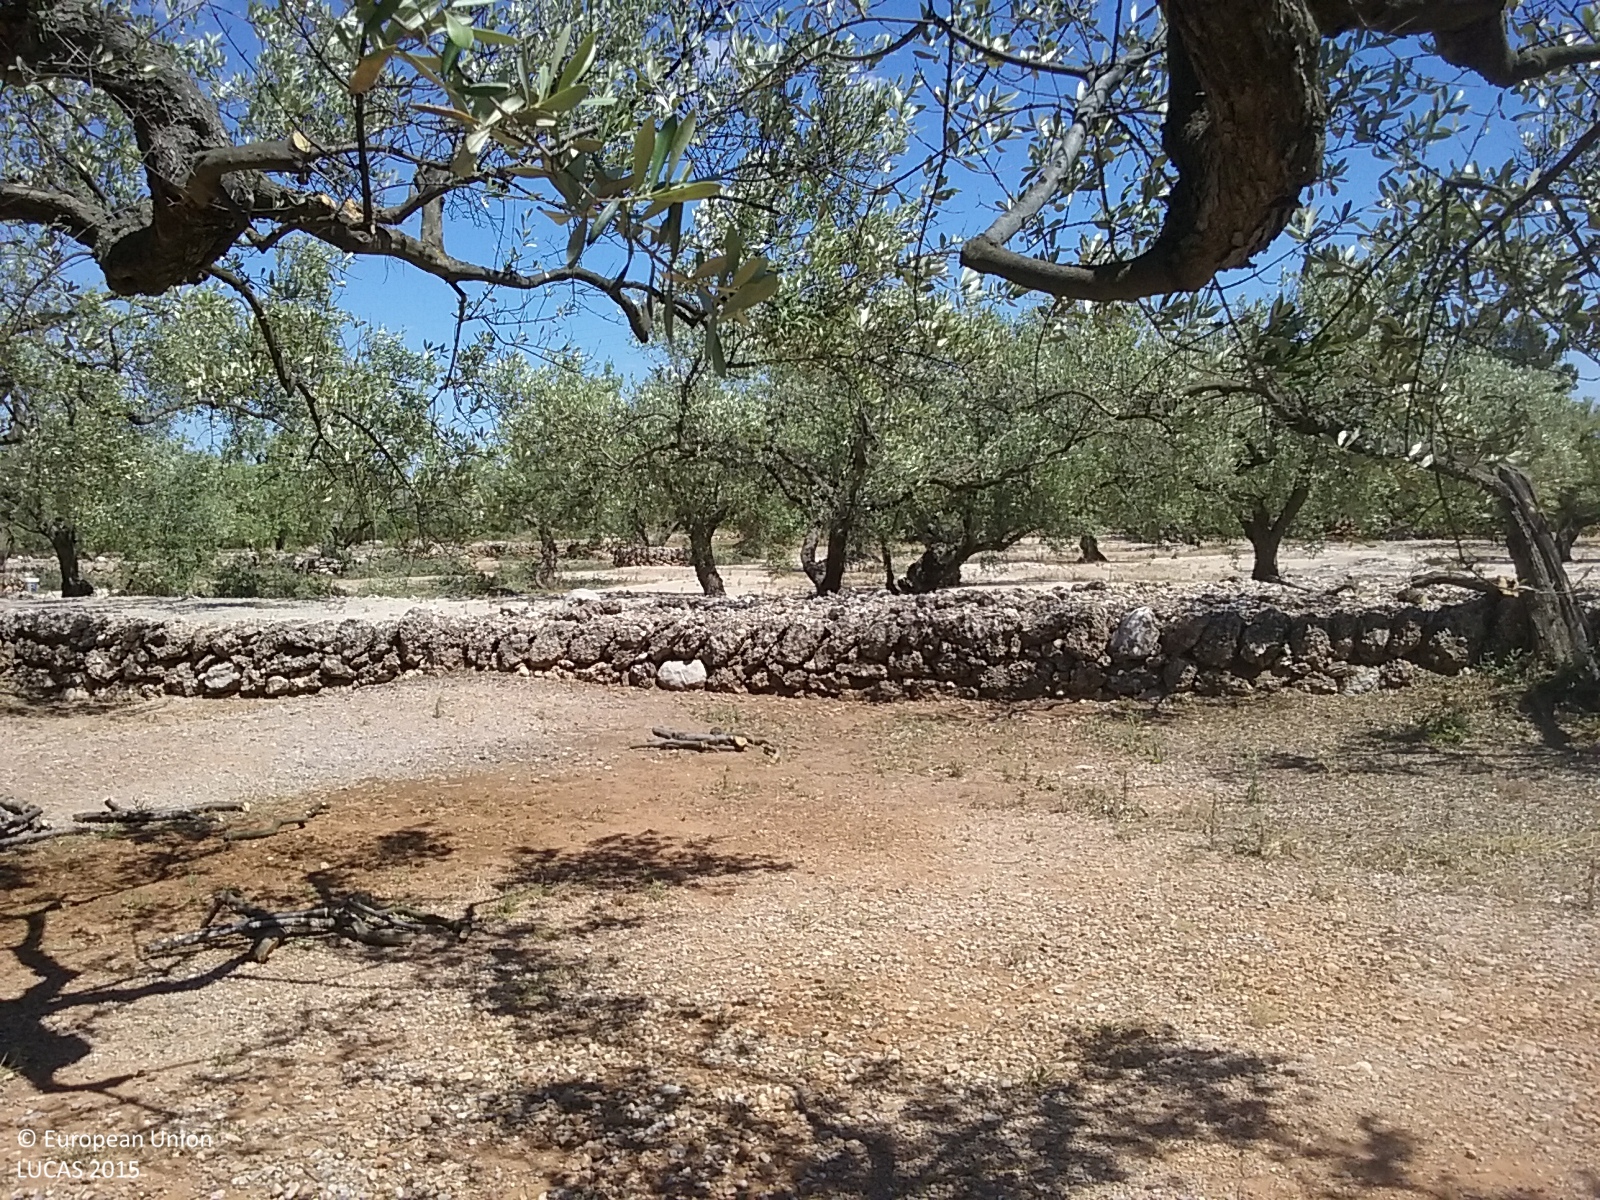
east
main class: Cropland
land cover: Olive groves
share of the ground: 50 - 75 %
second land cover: Other bare soil
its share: > 75 %
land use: Agriculture (excluding fallow land and kitchen gardens)
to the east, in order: Olive groves; Other bare soil; Dry stone walls; Olive groves; Dry stone walls; Shrubland with sparse tree cover; Grass margins; Paved roads, cycling and walking lanes; Shrubland with sparse tree cover; Ditches and canals; Shrubland with sparse tree cover; Electric lines; Shrubland with sparse tree cover; Dry stone walls; Olive groves; Dry stone walls; Olive groves
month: May
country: ES
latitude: 40.7232
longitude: 0.3926
